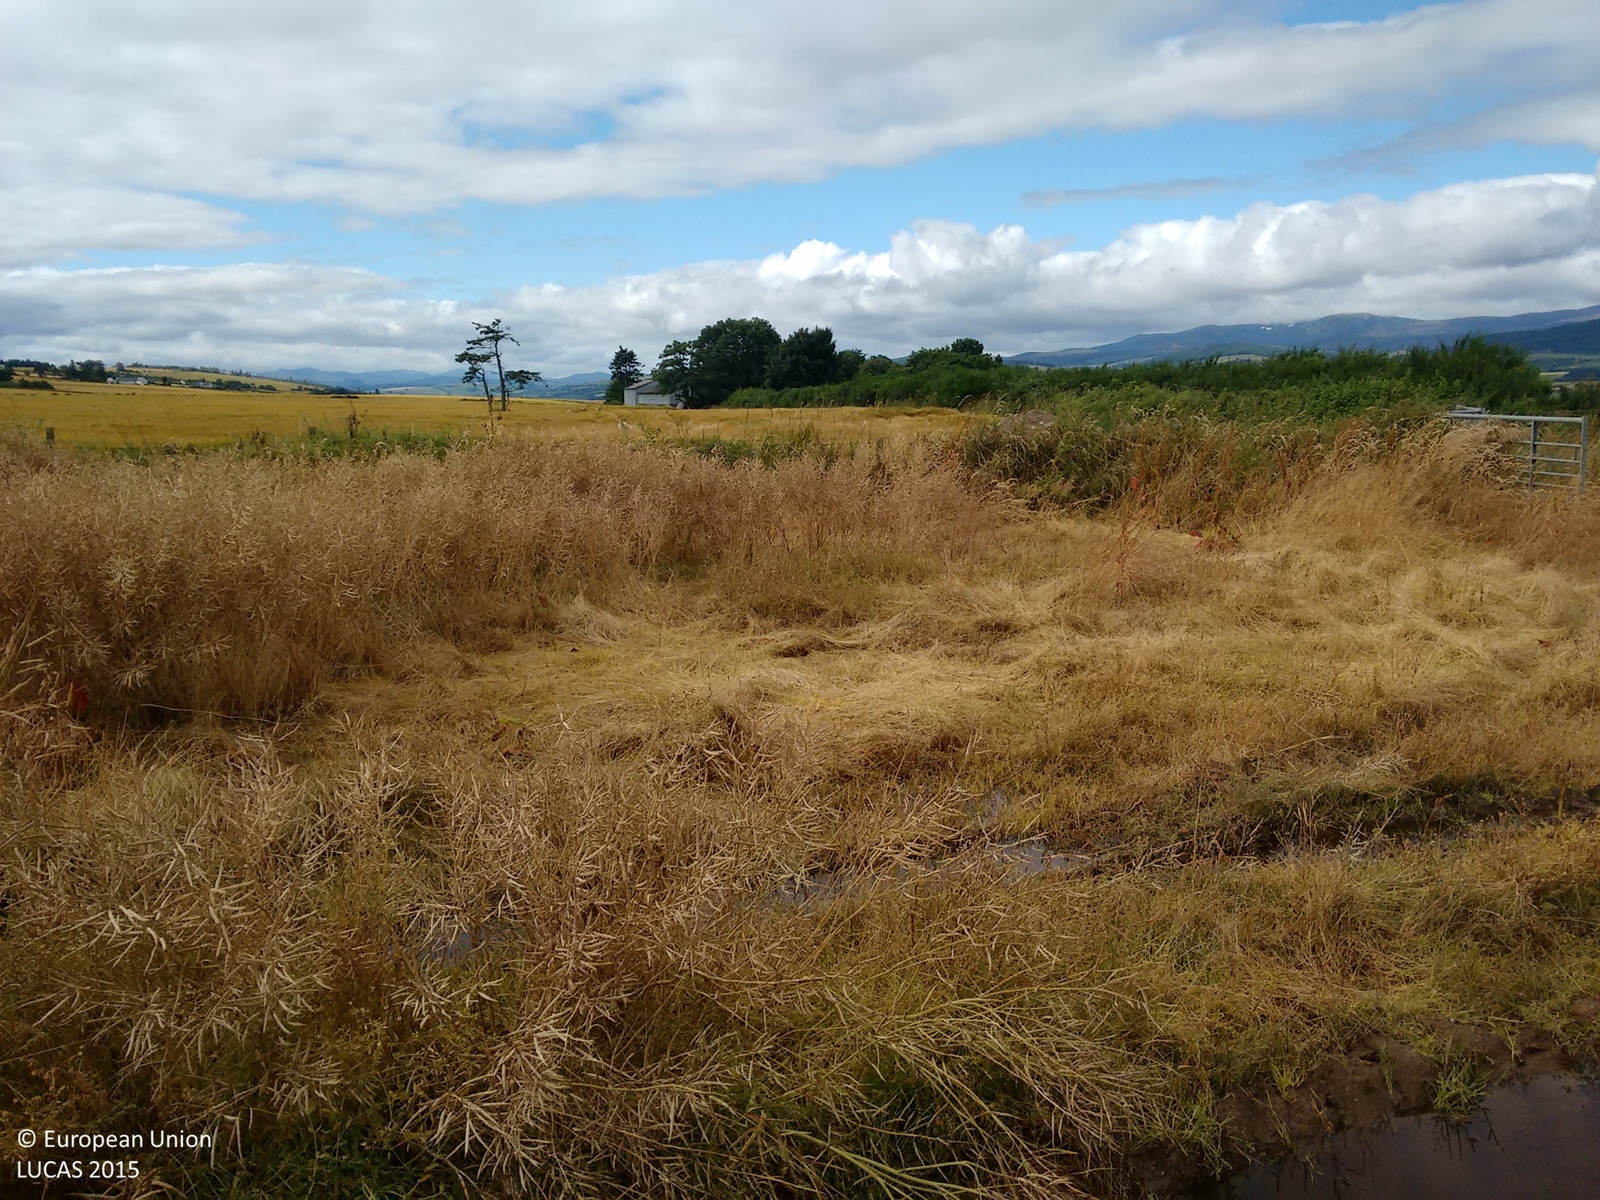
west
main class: Cropland
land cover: Rape and turnip rape
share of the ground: > 75 %
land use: Agriculture (excluding fallow land and kitchen gardens)
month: August
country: GB
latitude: 57.6565
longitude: -4.2460
